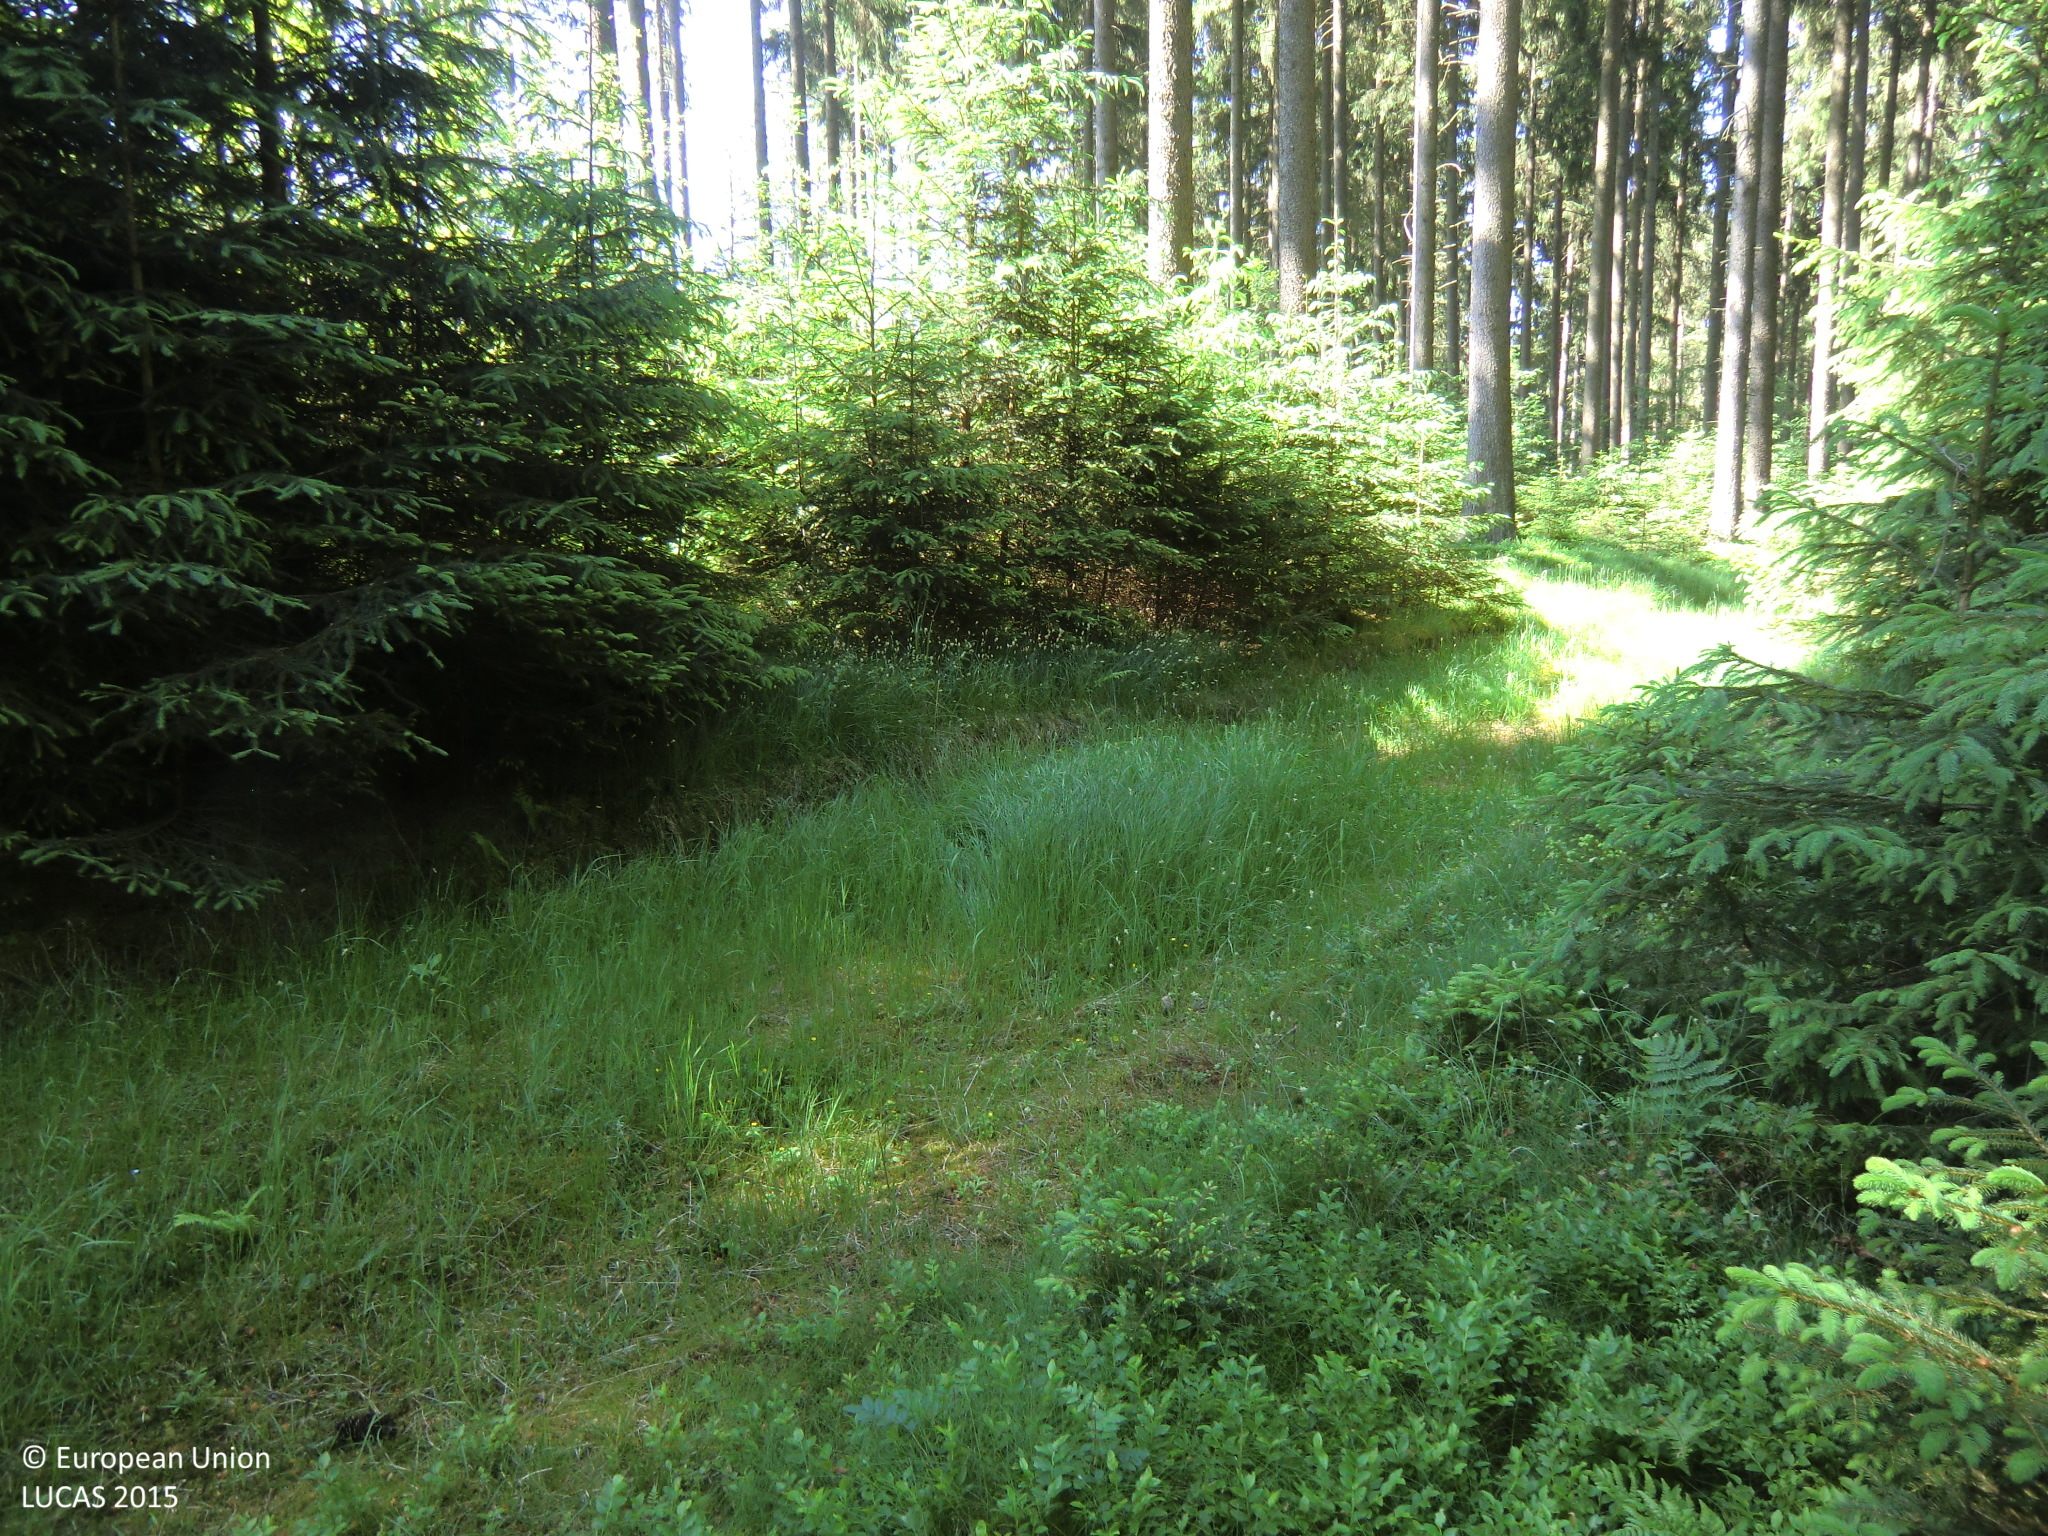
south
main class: Woodland
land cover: Spruce dominated coniferous woodland
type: hemiboreal forest and nemoral coniferous forest and mixed broadleaved-coniferous forest
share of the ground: > 75 %
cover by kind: coniferous forest trees 80 %, shrubs 10 %, herbaceous plants 10 %
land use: Forestry
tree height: > 5 m
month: June
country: AT
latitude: 48.4814
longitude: 14.3161
